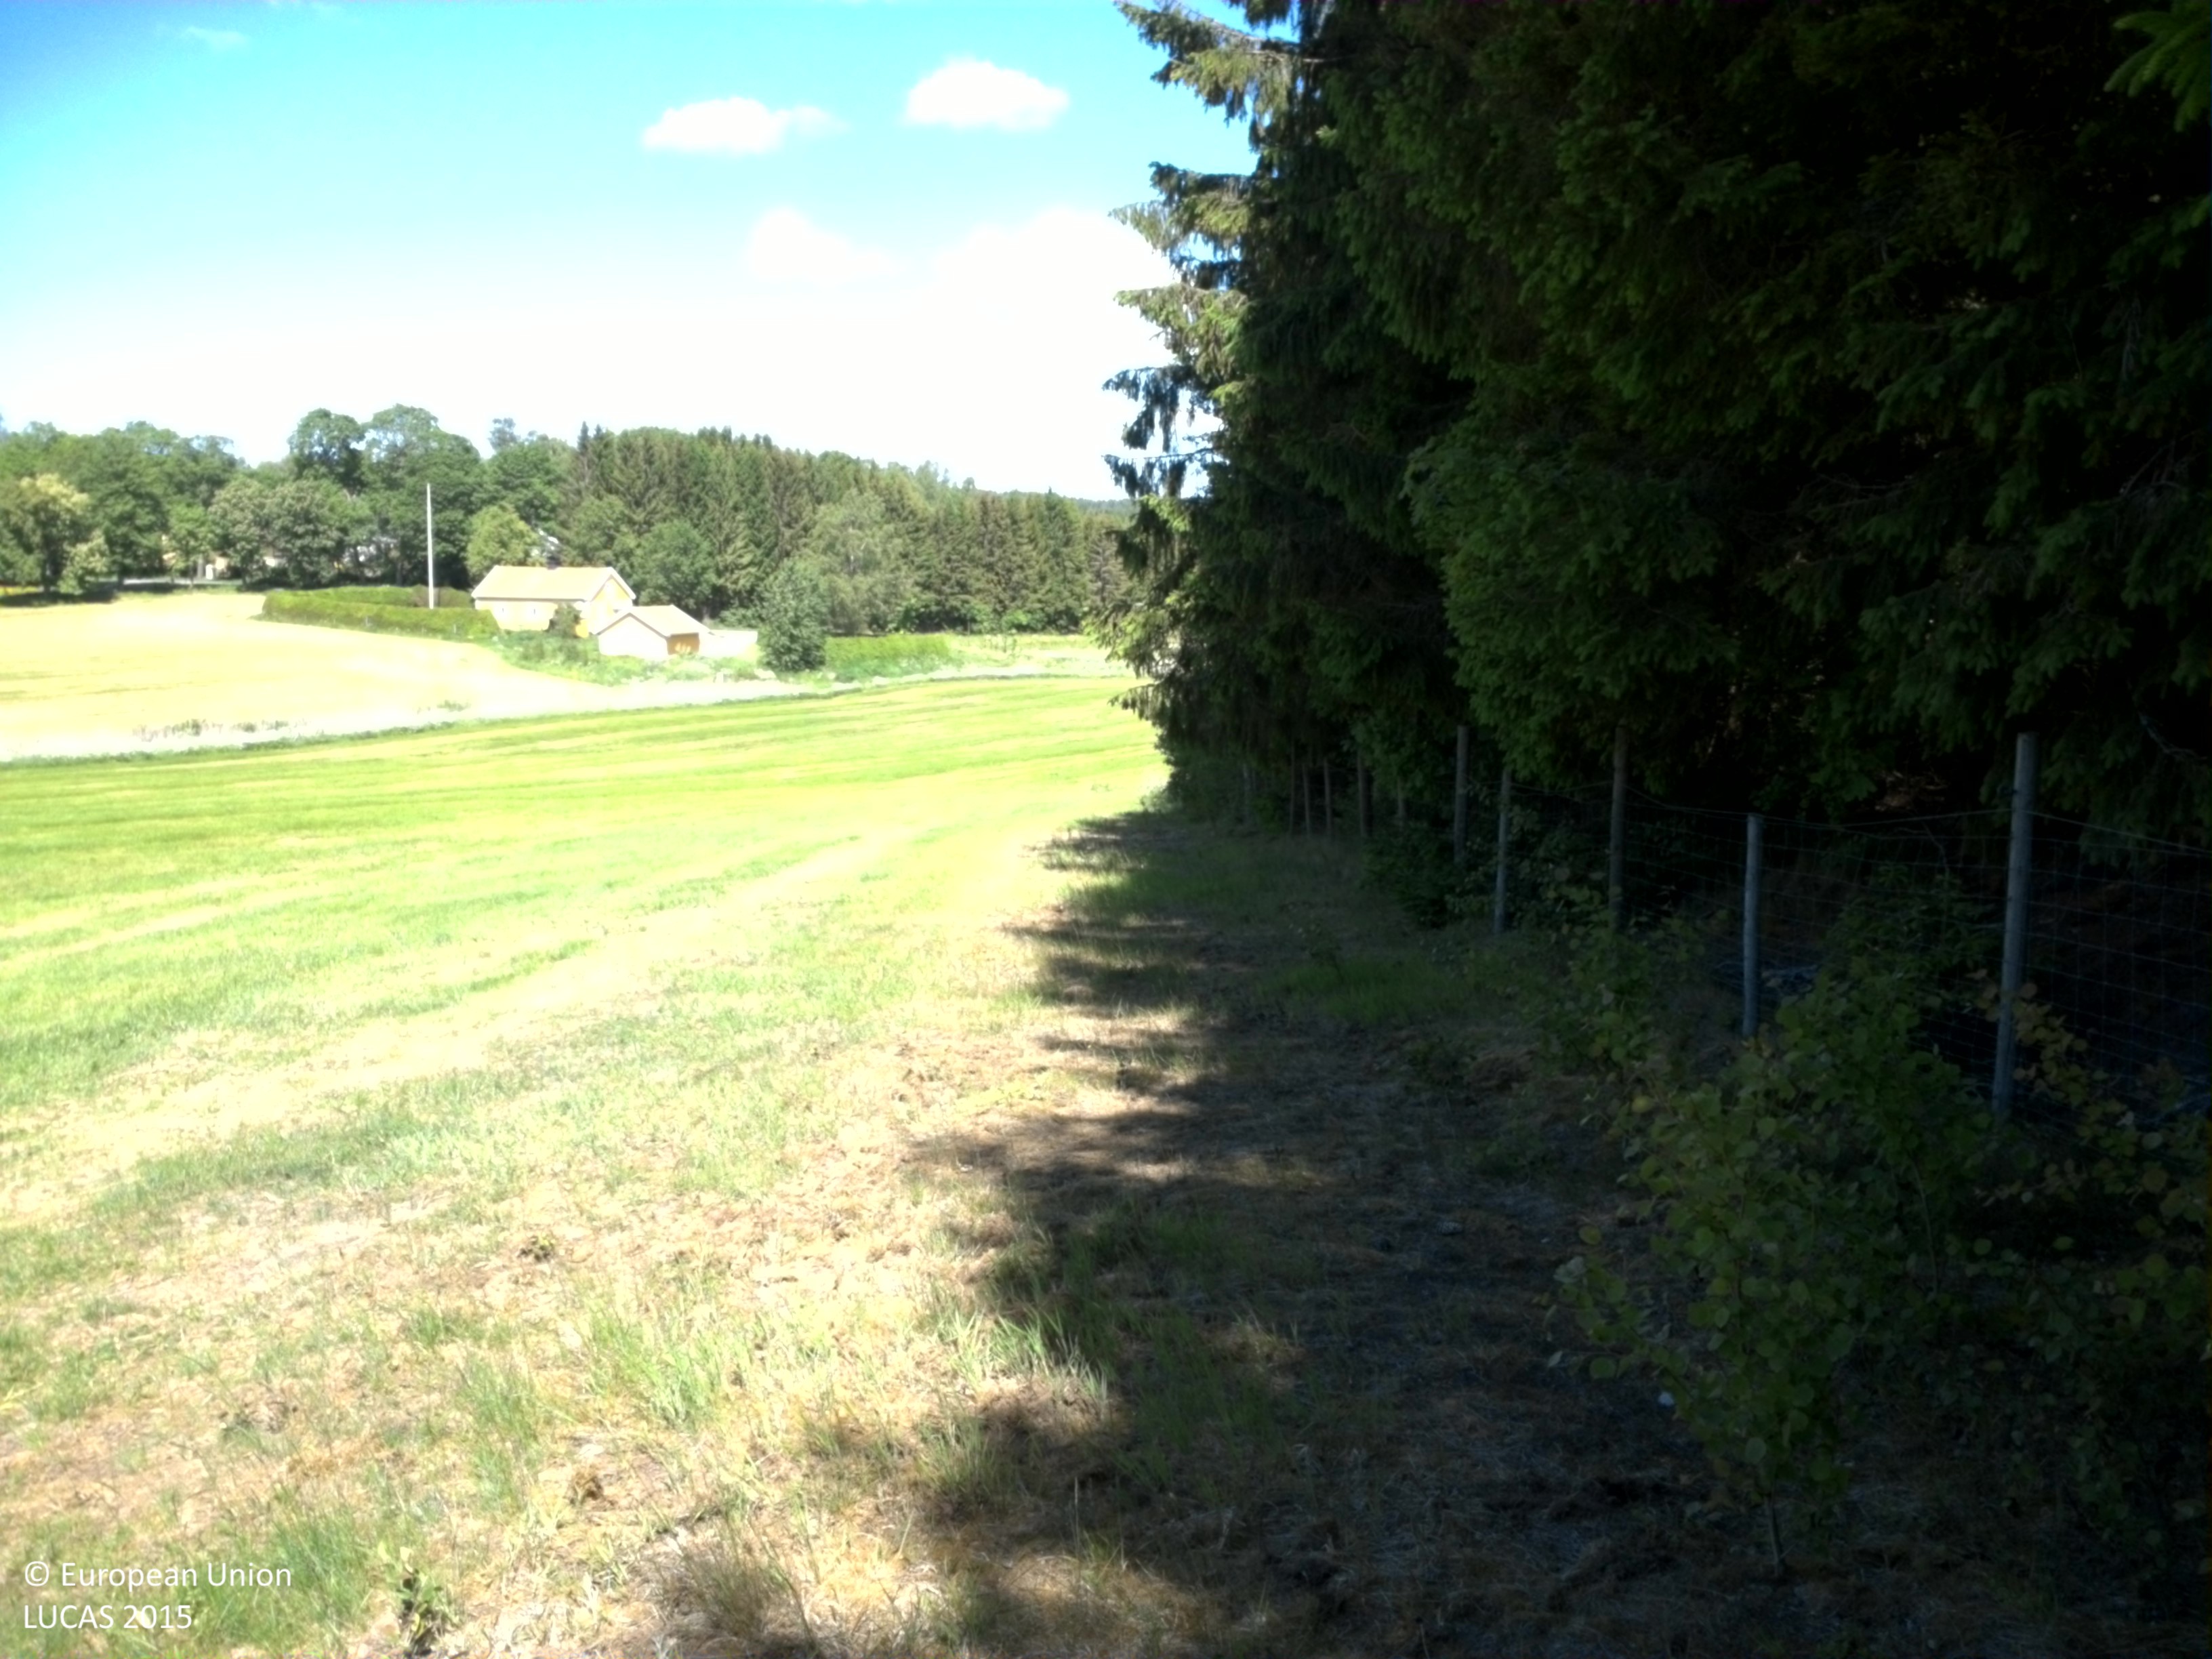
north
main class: Grassland
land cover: Grassland without tree/shrub cover
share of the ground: > 75 %
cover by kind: herbaceous plants 100 %
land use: Agriculture (excluding fallow land and kitchen gardens)
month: June
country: SE
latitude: 58.6008
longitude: 14.3126
